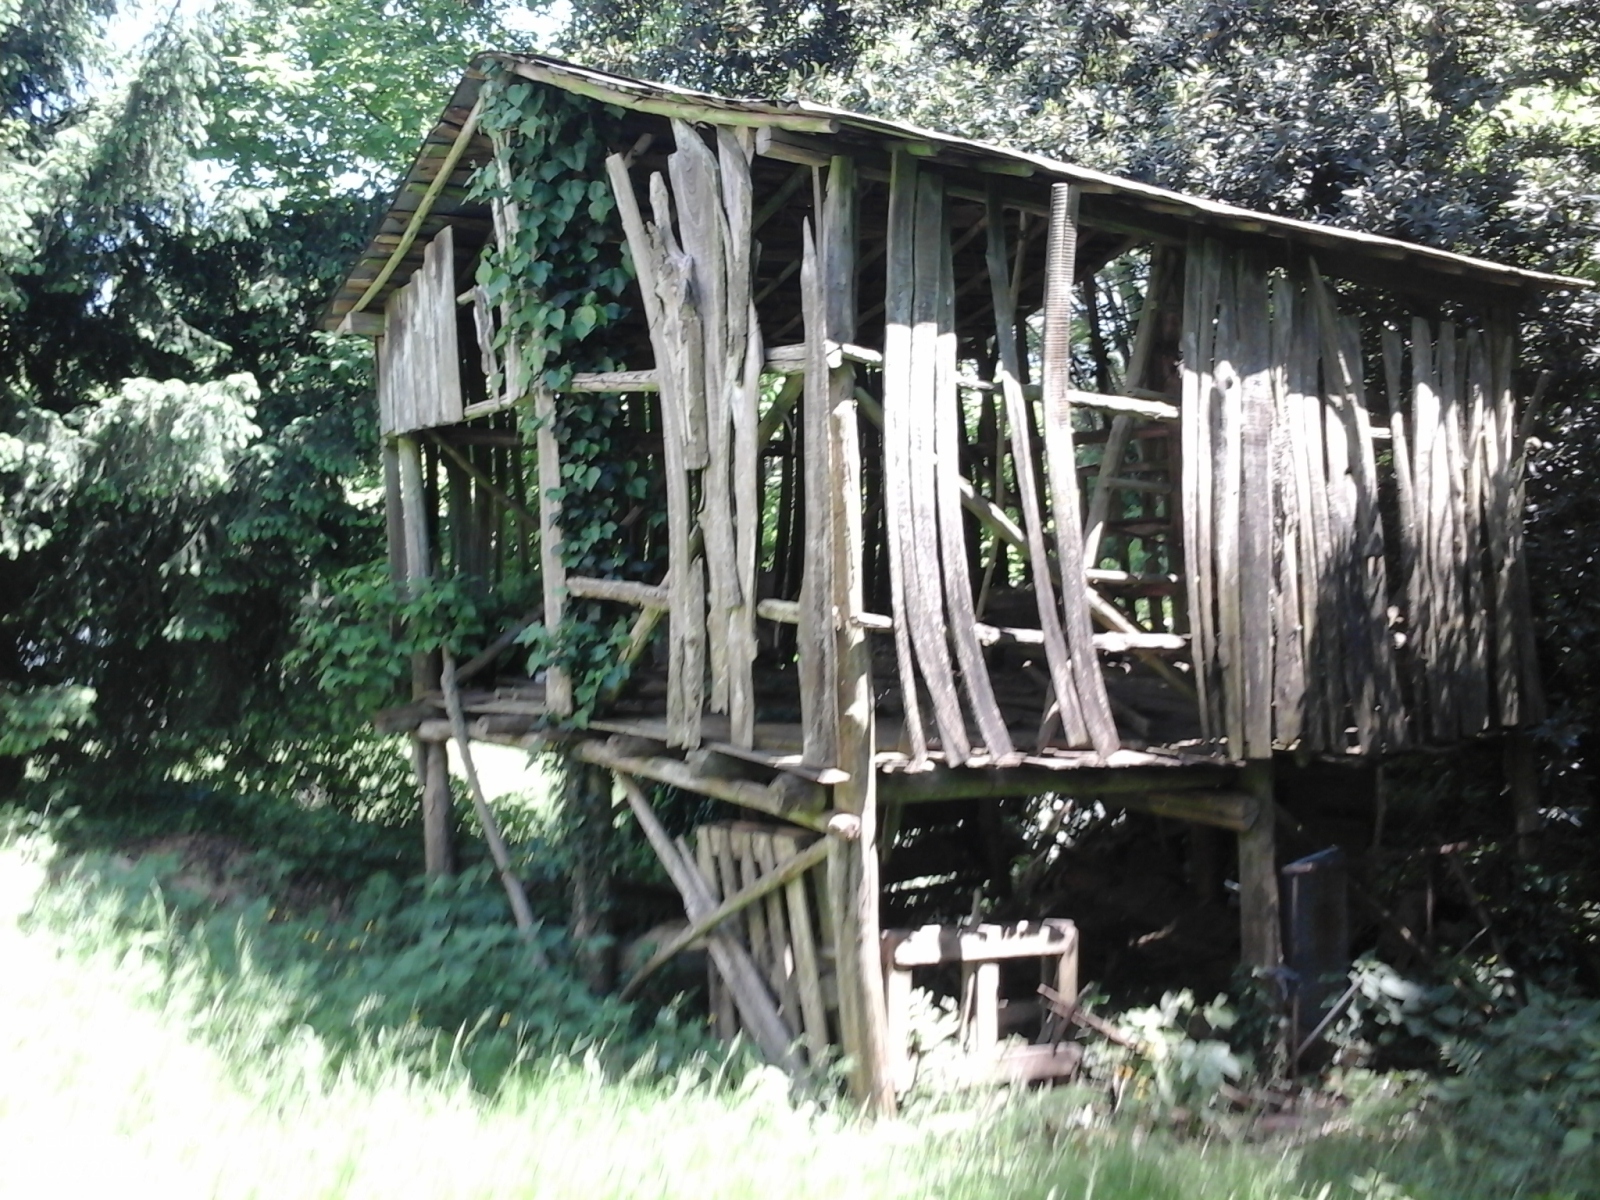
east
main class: Woodland
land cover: Broadleaved woodland
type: thermophilous deciduous forest
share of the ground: > 75 %
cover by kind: broadleaved forest trees 100 %
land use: Semi-natural and natural areas not in use
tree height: > 5 m
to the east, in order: Broadleaved woodland; Grassland without tree/shrub cover; Olive groves; Grassland without tree/shrub cover; Olive groves; Broadleaved woodland; Ditches and canals; Grassland without tree/shrub cover; Other fruit trees and berries; Other fresh vegetables; Other fruit trees and berries; Olive groves
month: May
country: IT
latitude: 45.3102
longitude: 11.7189
